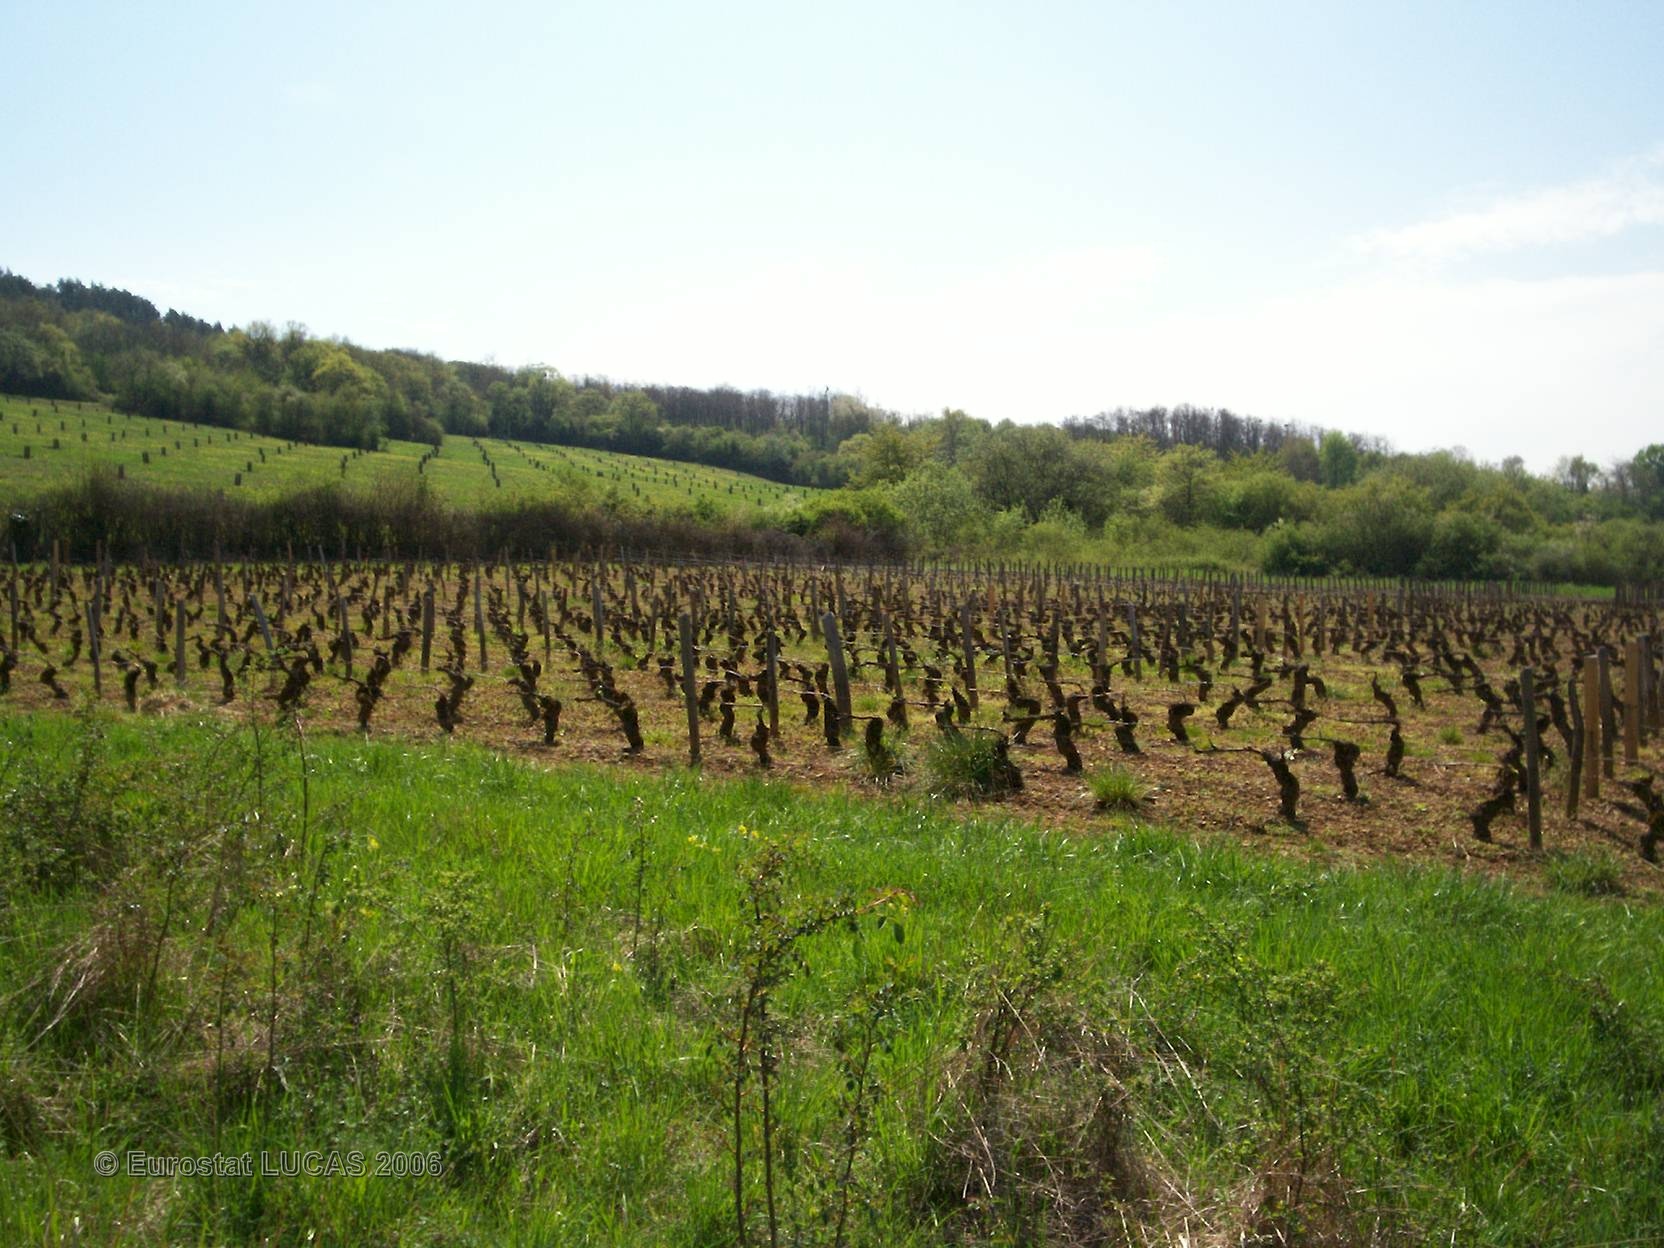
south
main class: Grassland
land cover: Grassland without tree/shrub cover
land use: Unused
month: April
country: FR
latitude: 46.8869
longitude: 4.6858
